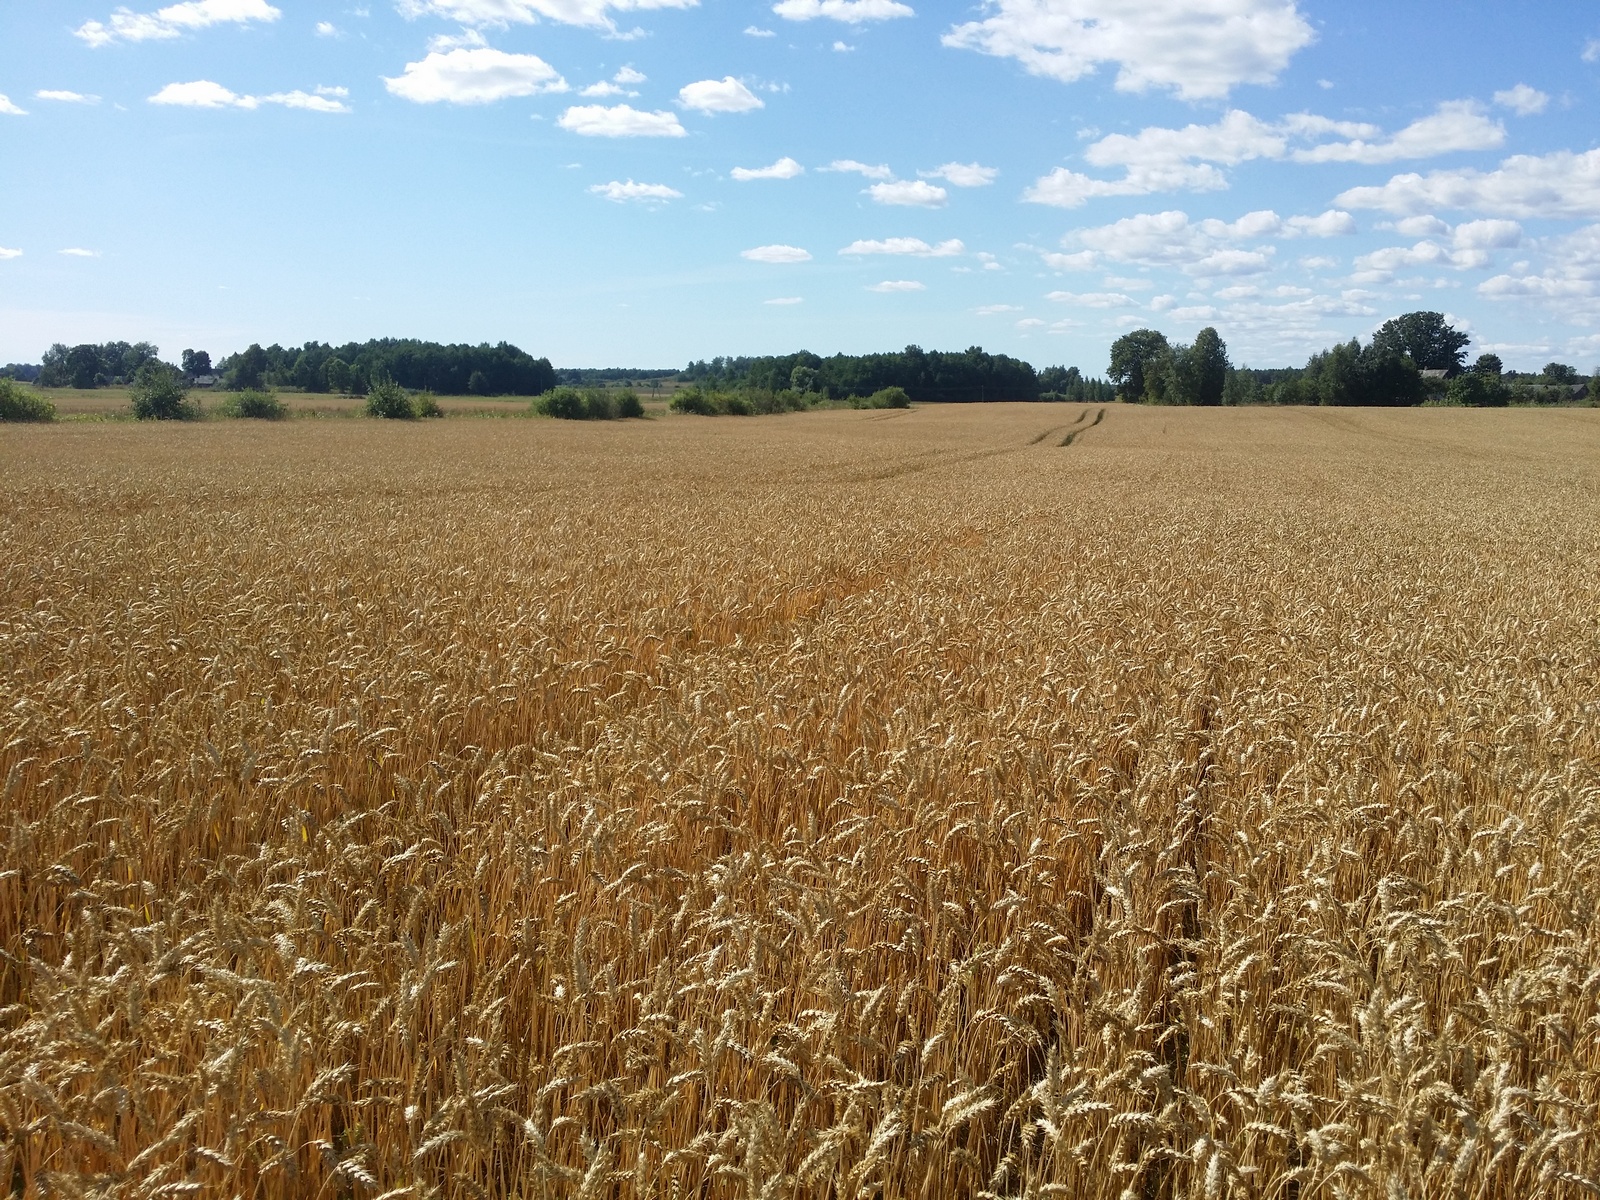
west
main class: Cropland
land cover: Common wheat
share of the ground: > 75 %
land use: Agriculture (excluding fallow land and kitchen gardens)
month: August
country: LV
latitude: 56.9951
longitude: 27.6804
